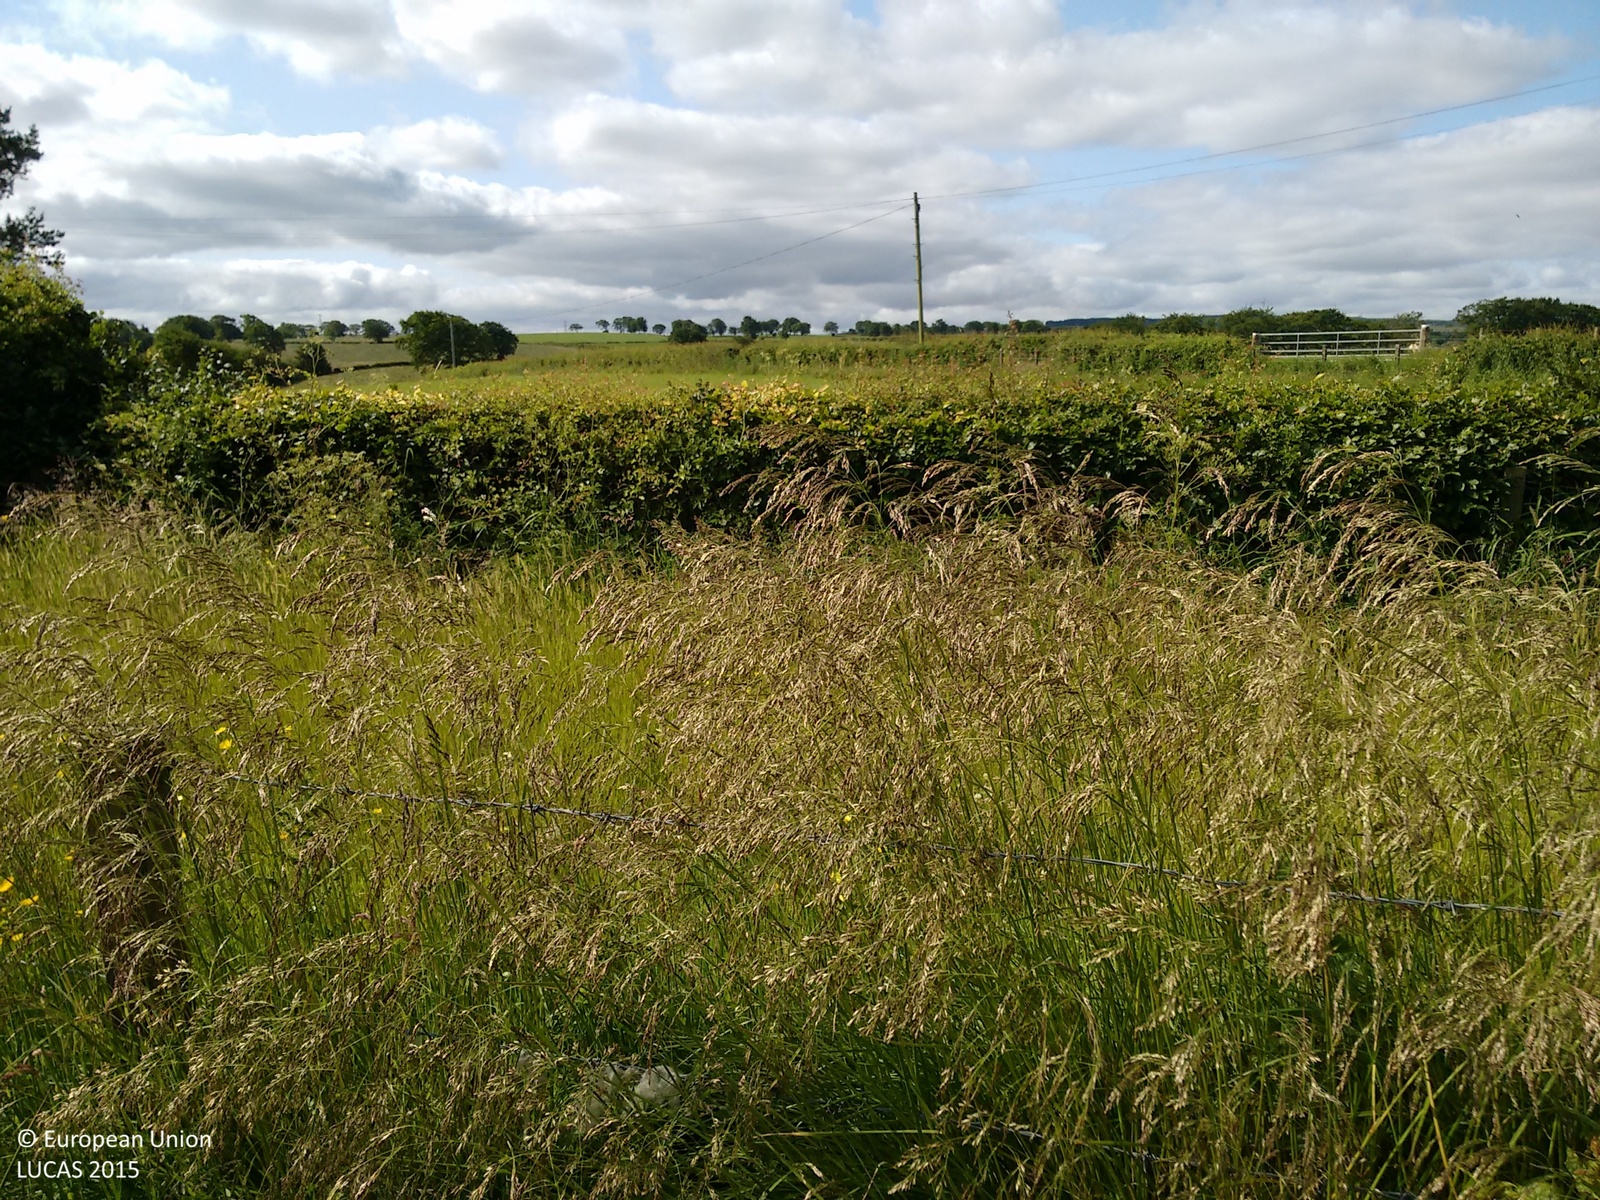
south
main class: Grassland
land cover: Grassland without tree/shrub cover
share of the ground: > 75 %
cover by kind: herbaceous plants 90 %, unconsolidated bare surface 10 %
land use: Agriculture (excluding fallow land and kitchen gardens)
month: July
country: GB
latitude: 55.7271
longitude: -4.1512
